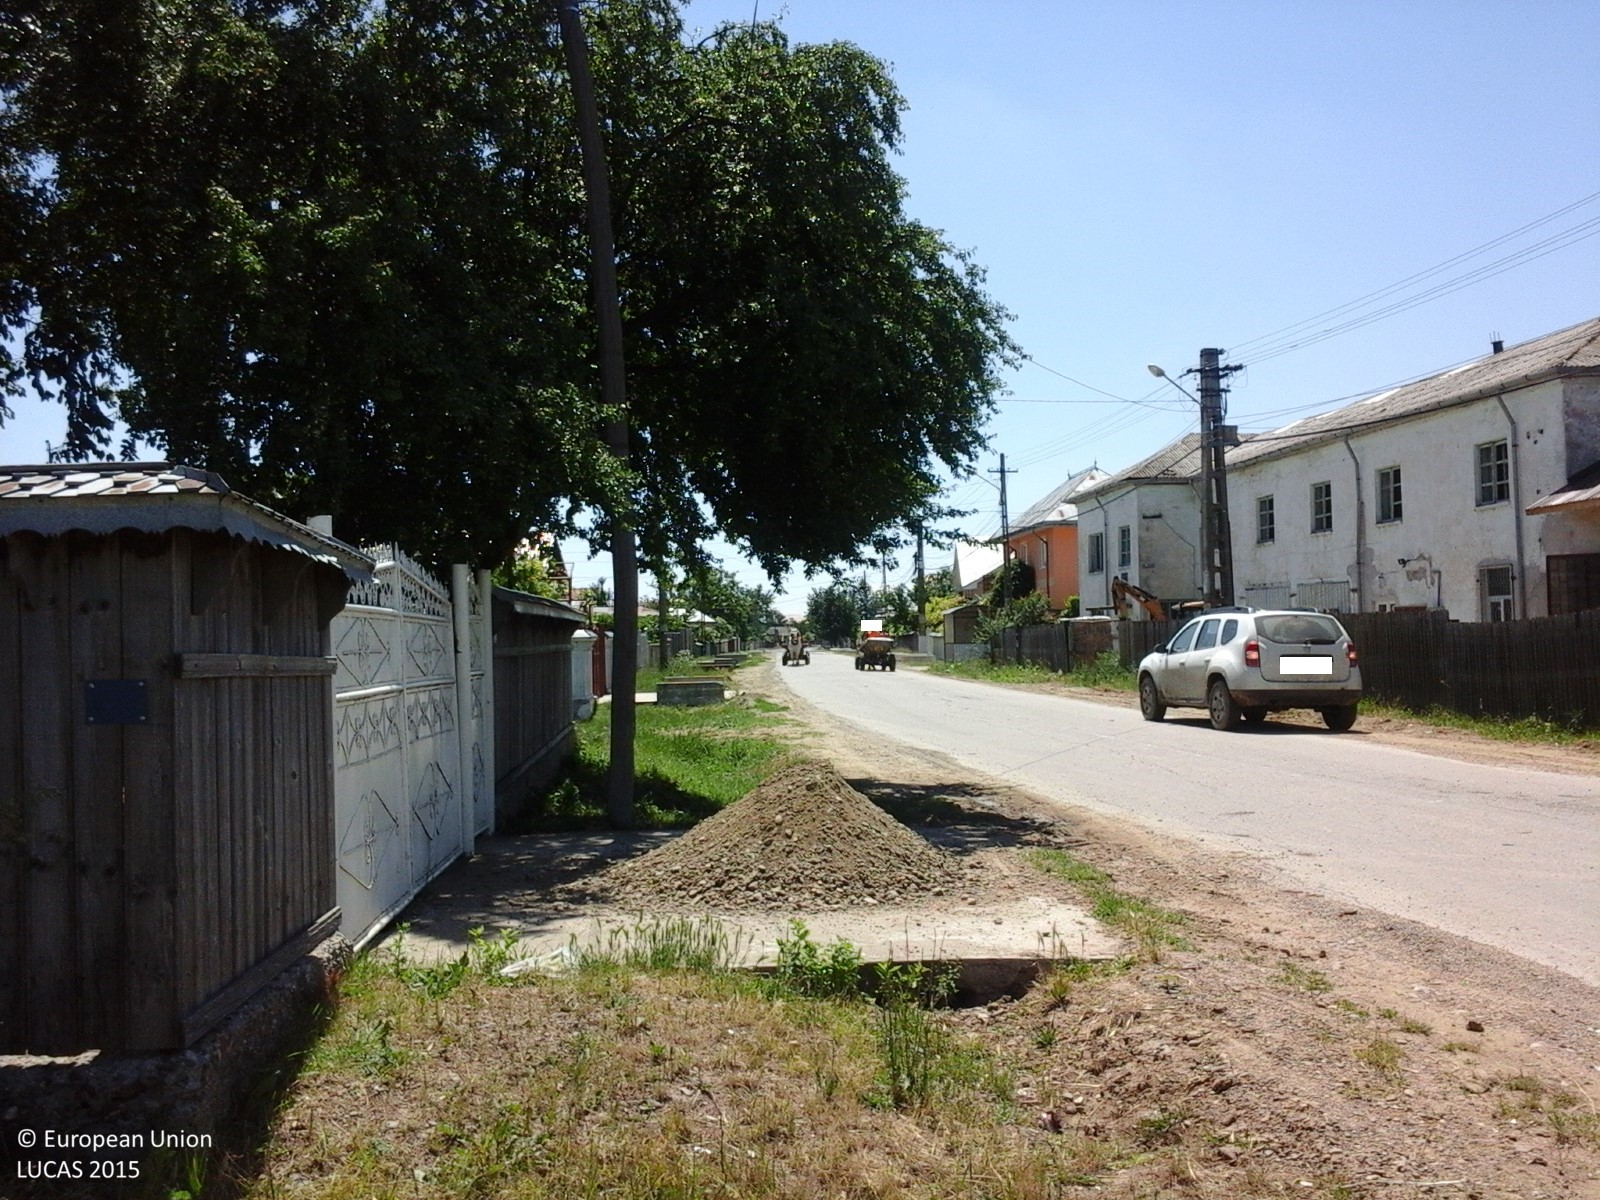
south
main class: Grassland
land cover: Grassland without tree/shrub cover
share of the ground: > 75 %
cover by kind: herbaceous plants 100 %
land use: Residential
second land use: Agriculture (excluding fallow land and kitchen gardens)
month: June
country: RO
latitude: 47.0047
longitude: 26.9733
